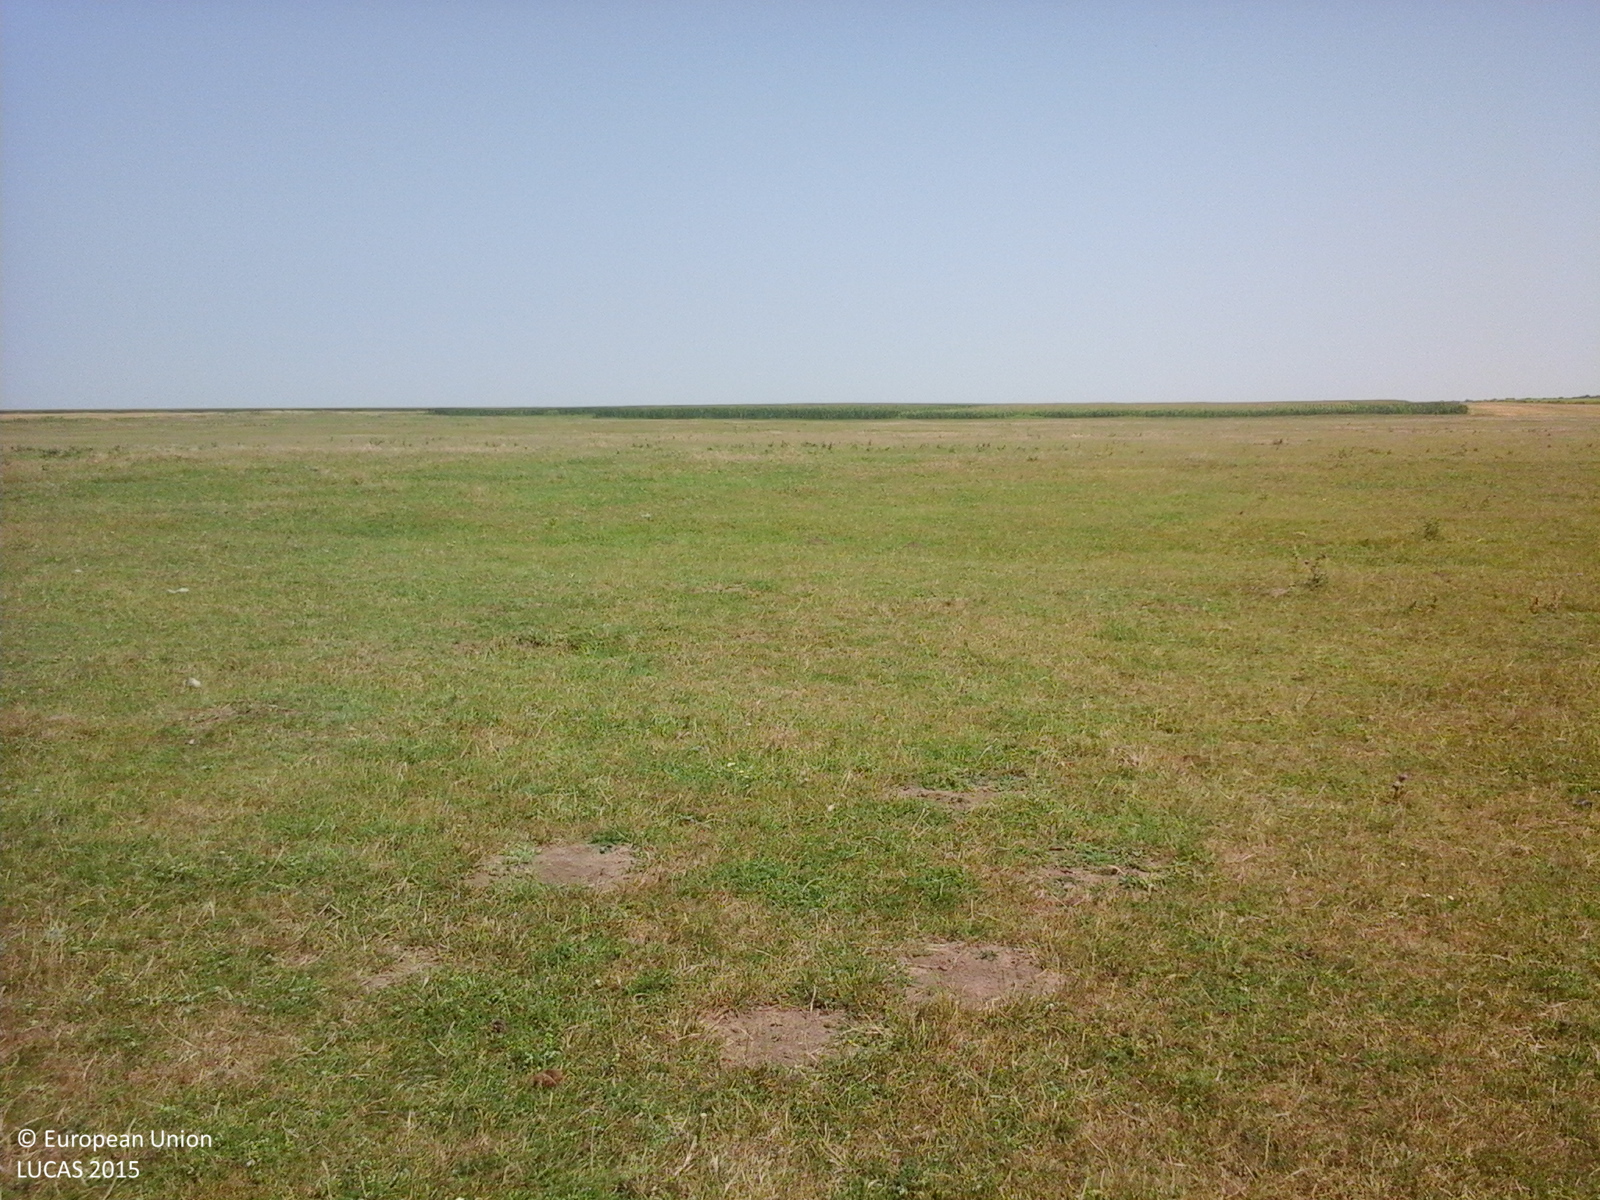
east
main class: Grassland
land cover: Grassland without tree/shrub cover
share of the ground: > 75 %
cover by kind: herbaceous plants 100 %
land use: Agriculture (excluding fallow land and kitchen gardens)
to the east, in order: Grassland without tree/shrub cover; Ditches and canals; Grassland without tree/shrub cover
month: July
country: RO
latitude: 44.7369
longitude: 27.1197
